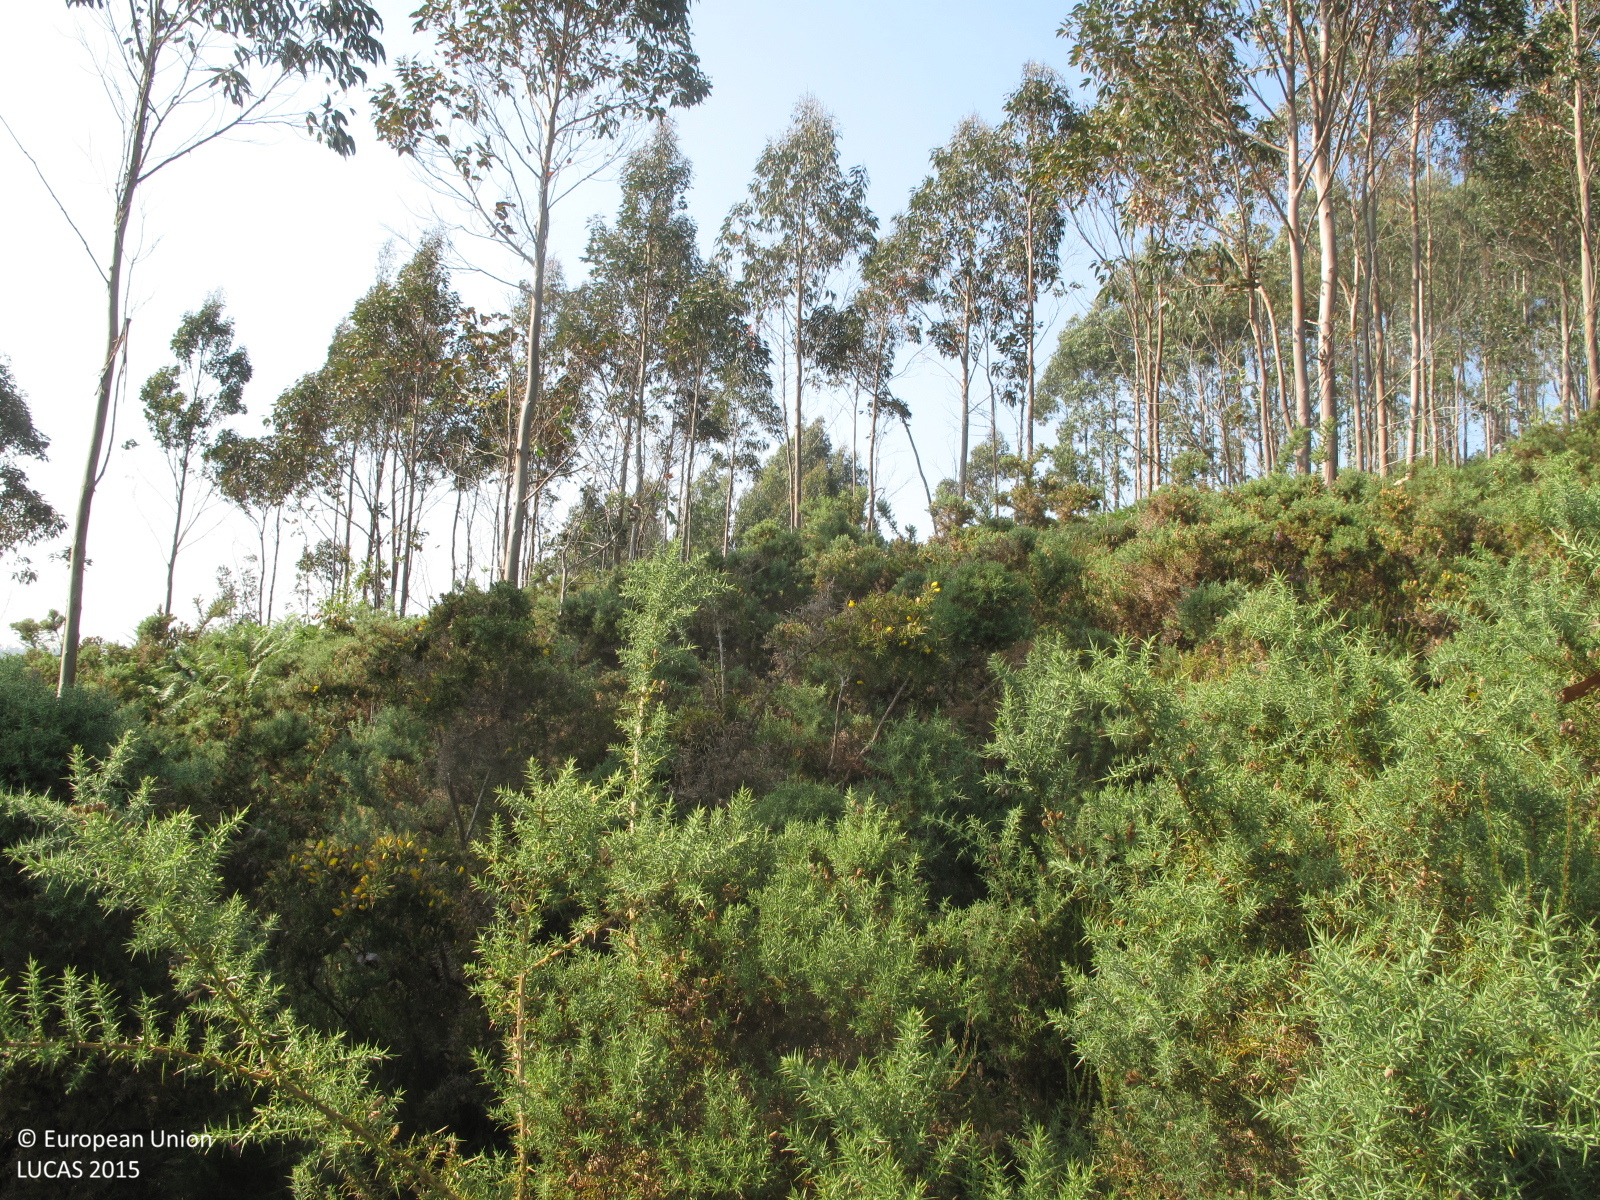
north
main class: Shrubland
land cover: Shrubland without tree cover
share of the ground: > 75 %
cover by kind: shrubs 90 %, herbaceous plants 10 %
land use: Semi-natural and natural areas not in use
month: June
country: ES
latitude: 43.2382
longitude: -8.0106
